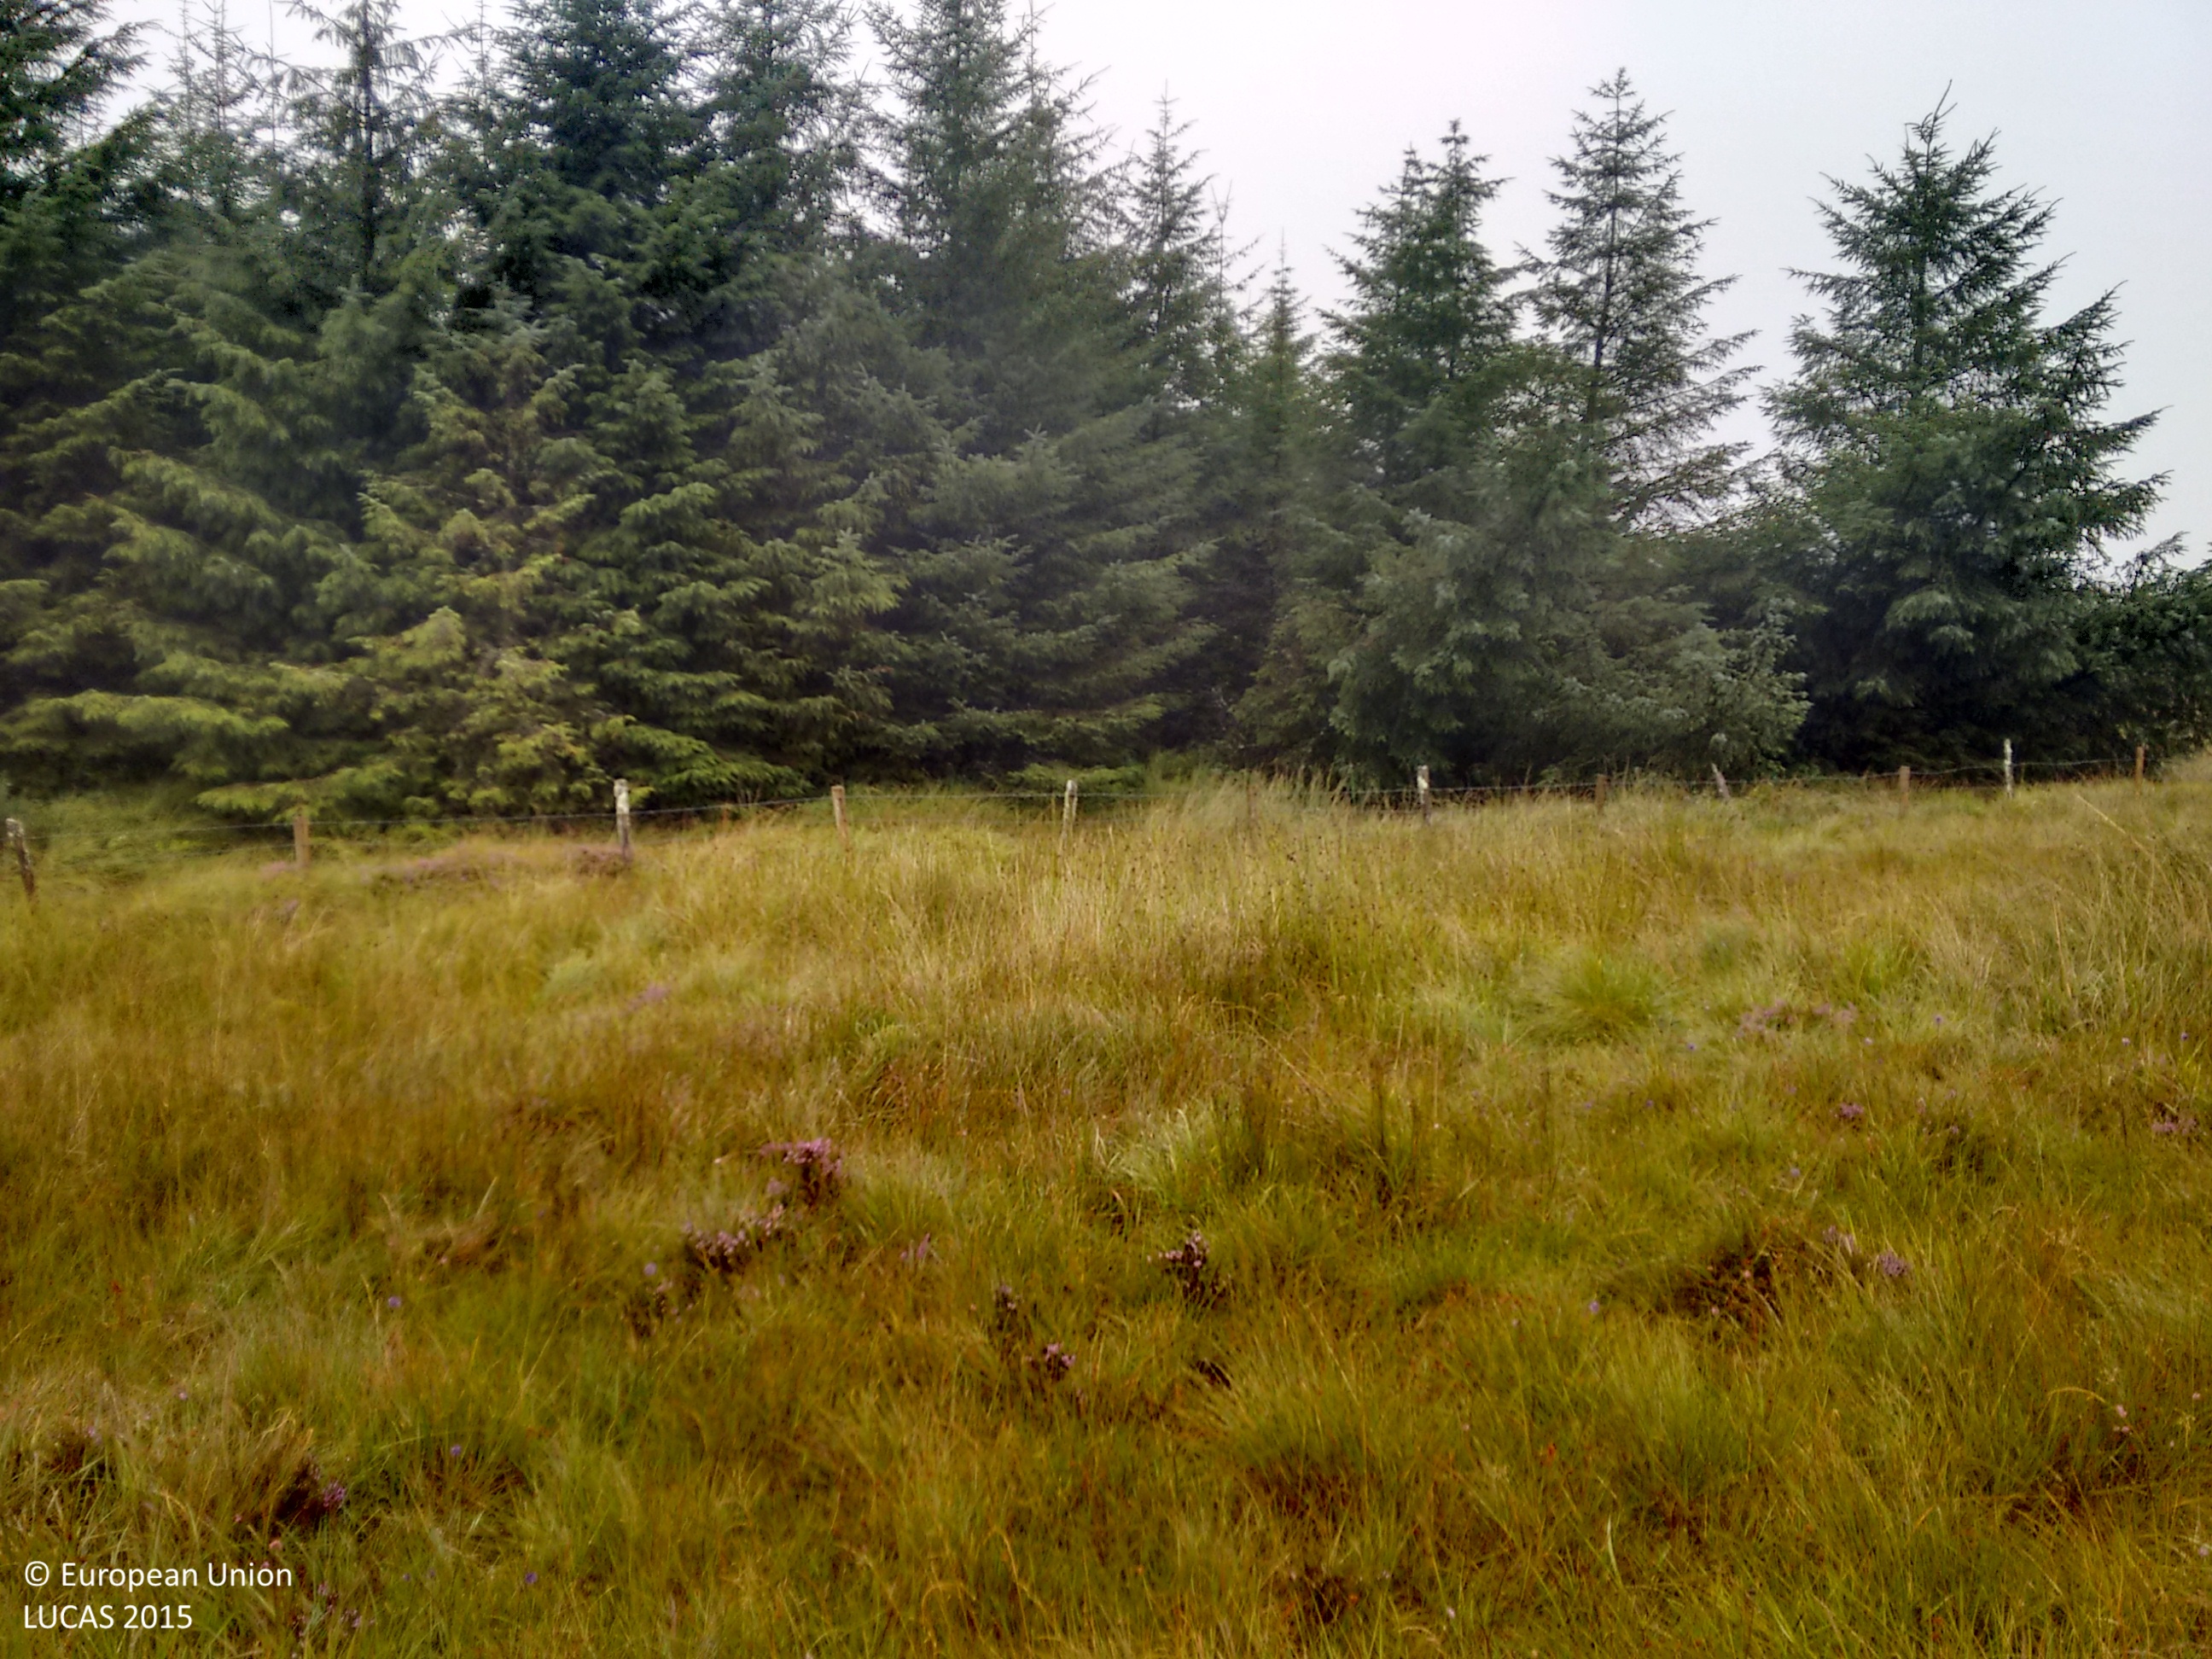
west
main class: Grassland
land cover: Grassland without tree/shrub cover
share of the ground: > 75 %
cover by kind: herbaceous plants 100 %
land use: Agriculture (excluding fallow land and kitchen gardens)
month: September
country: IE
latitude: 52.7387
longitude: -8.7007
